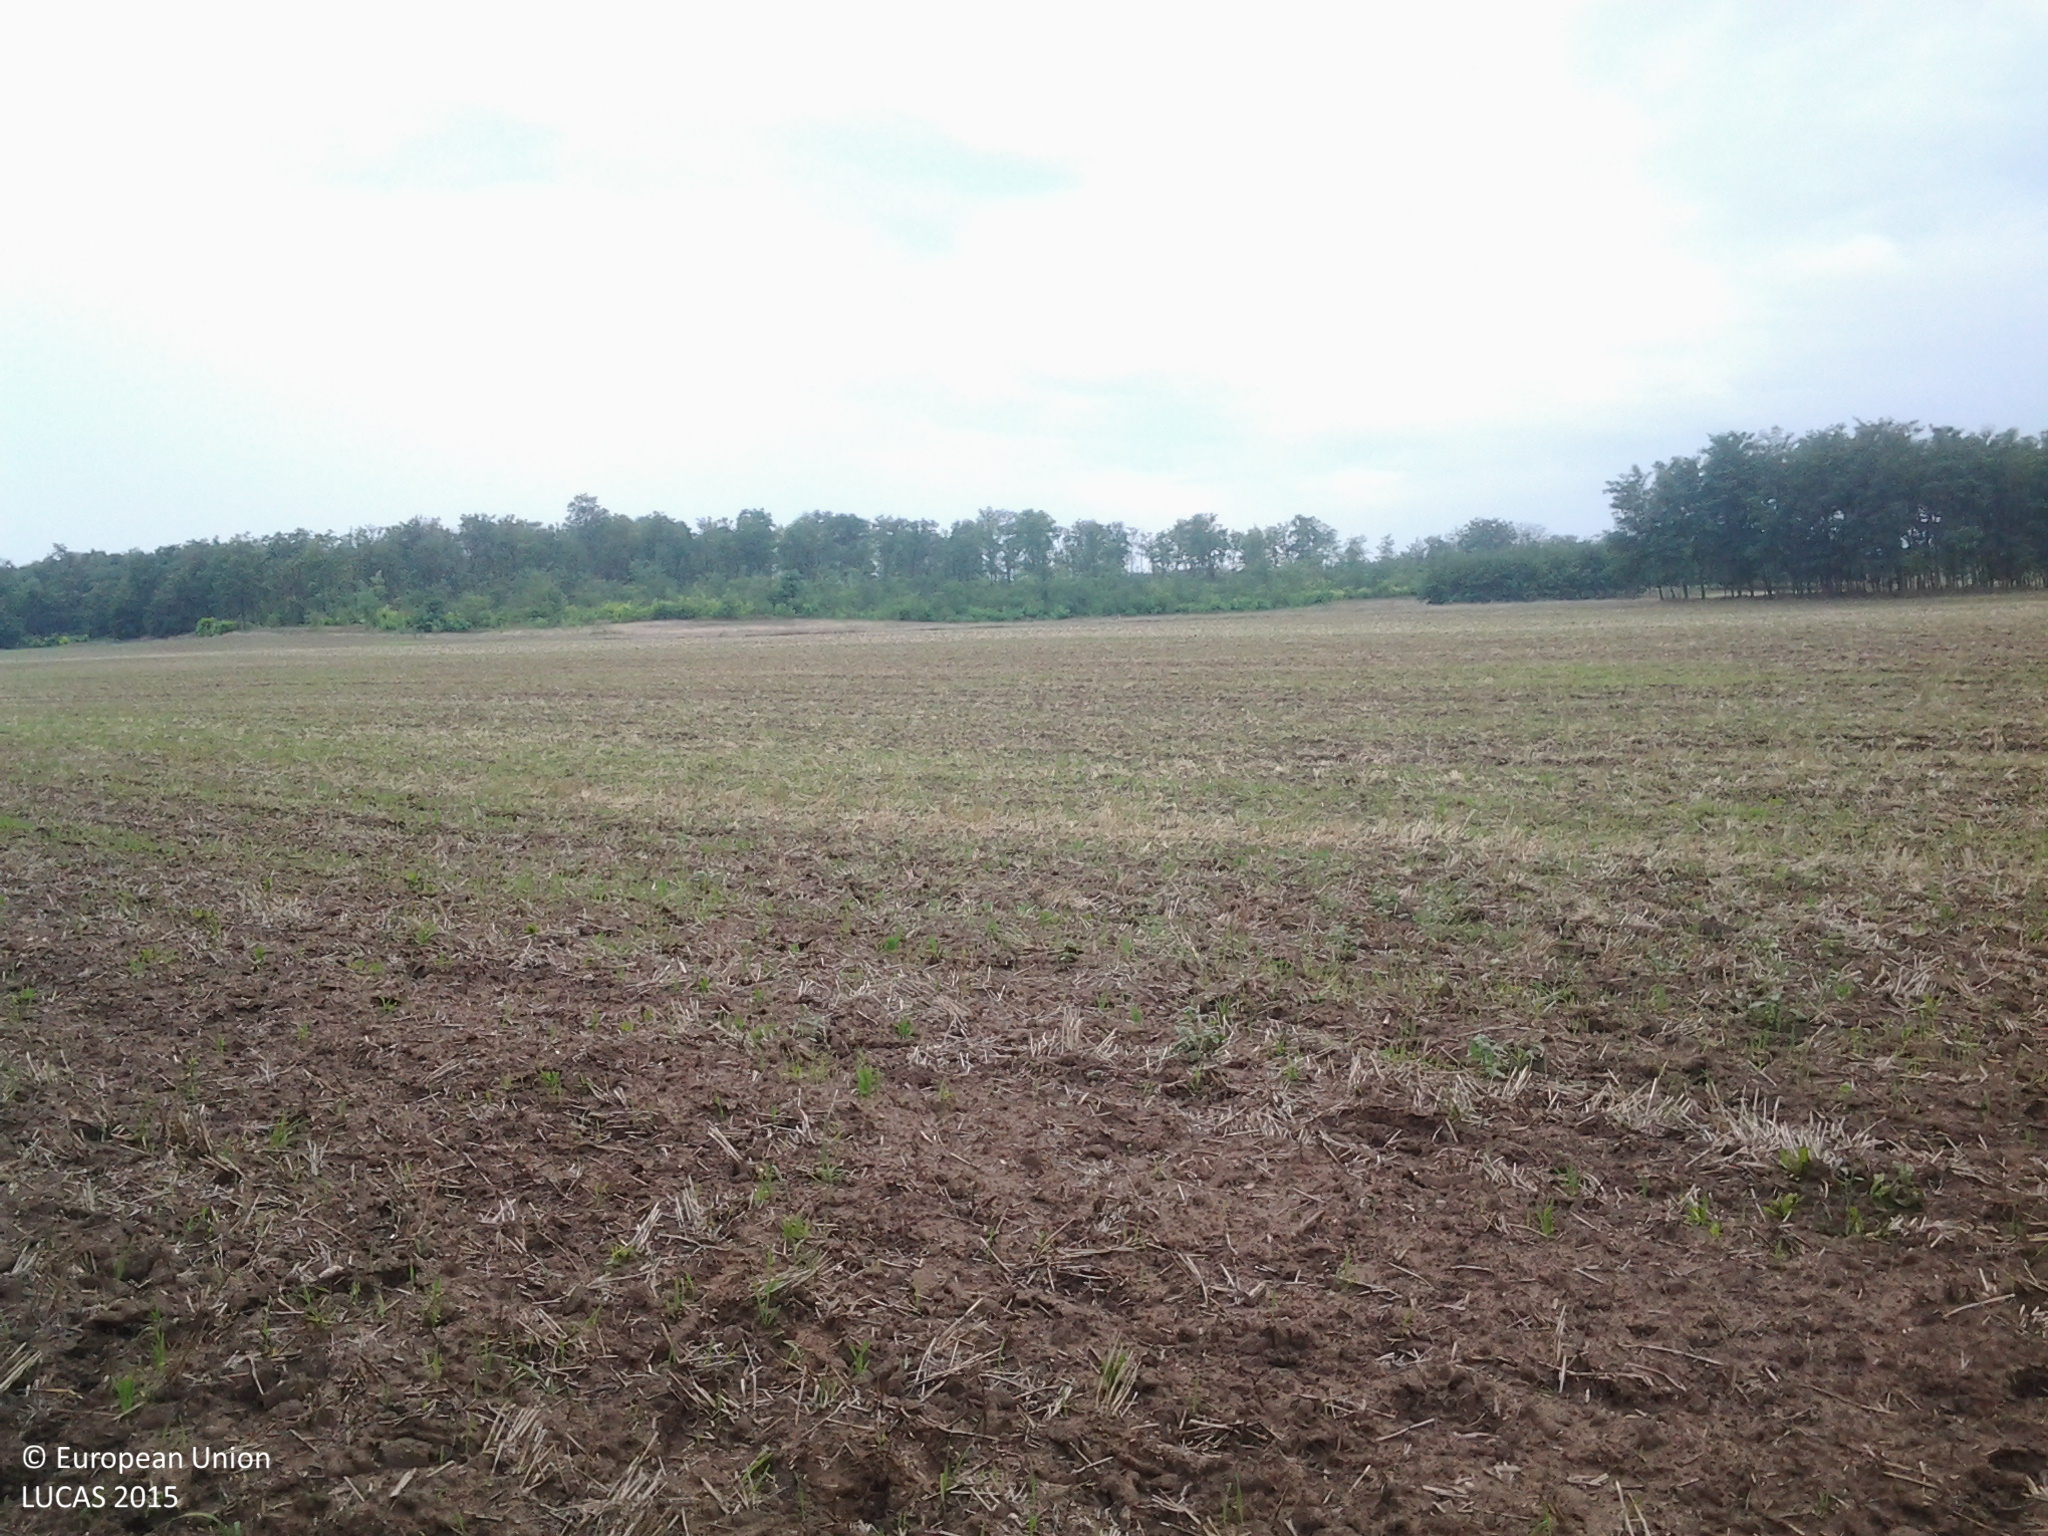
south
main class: Woodland
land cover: Broadleaved woodland
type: mesophytic deciduous forest
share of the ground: > 75 %
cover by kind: broadleaved forest trees 80 %, herbaceous plants 15 %, shrubs 5 %
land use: Forestry
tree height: > 5 m
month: August
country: HU
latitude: 46.0507
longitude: 18.9160
